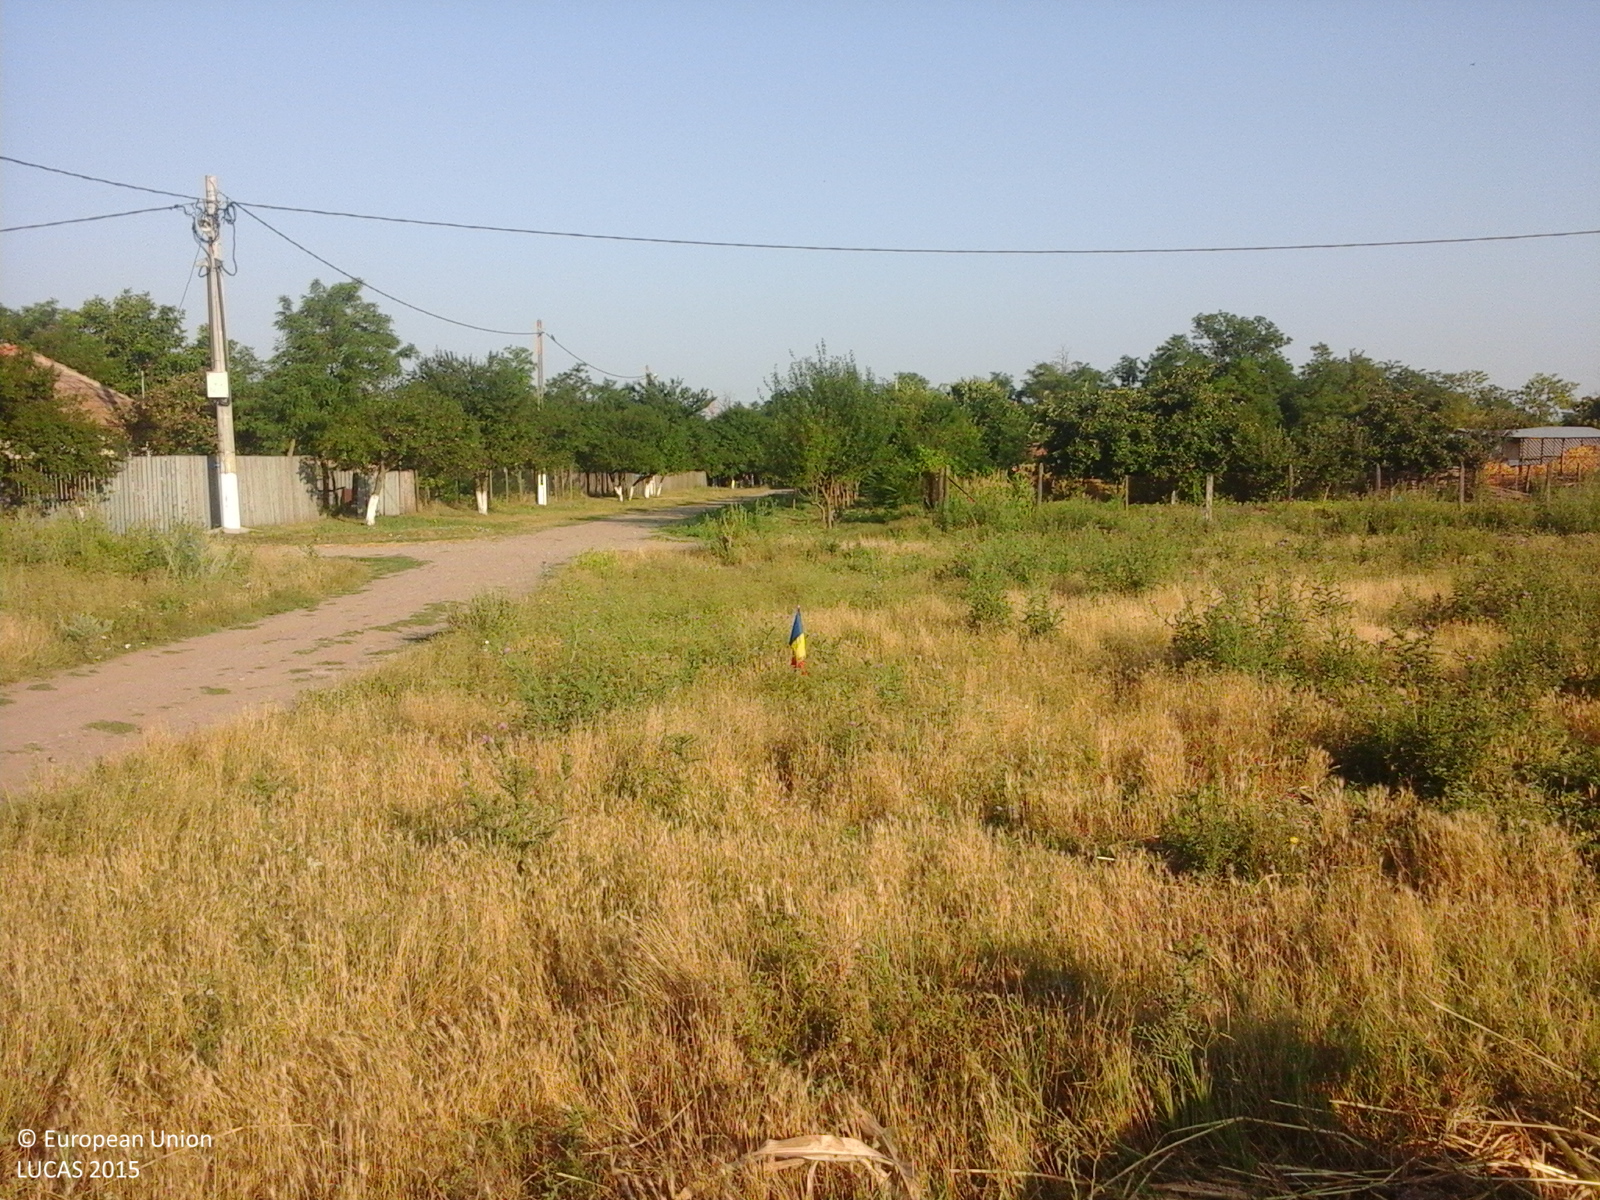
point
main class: Grassland
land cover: Spontaneously vegetated surfaces
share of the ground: > 75 %
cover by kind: herbaceous plants 100 %
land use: Semi-natural and natural areas not in use
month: July
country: RO
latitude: 44.4085
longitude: 26.9922
